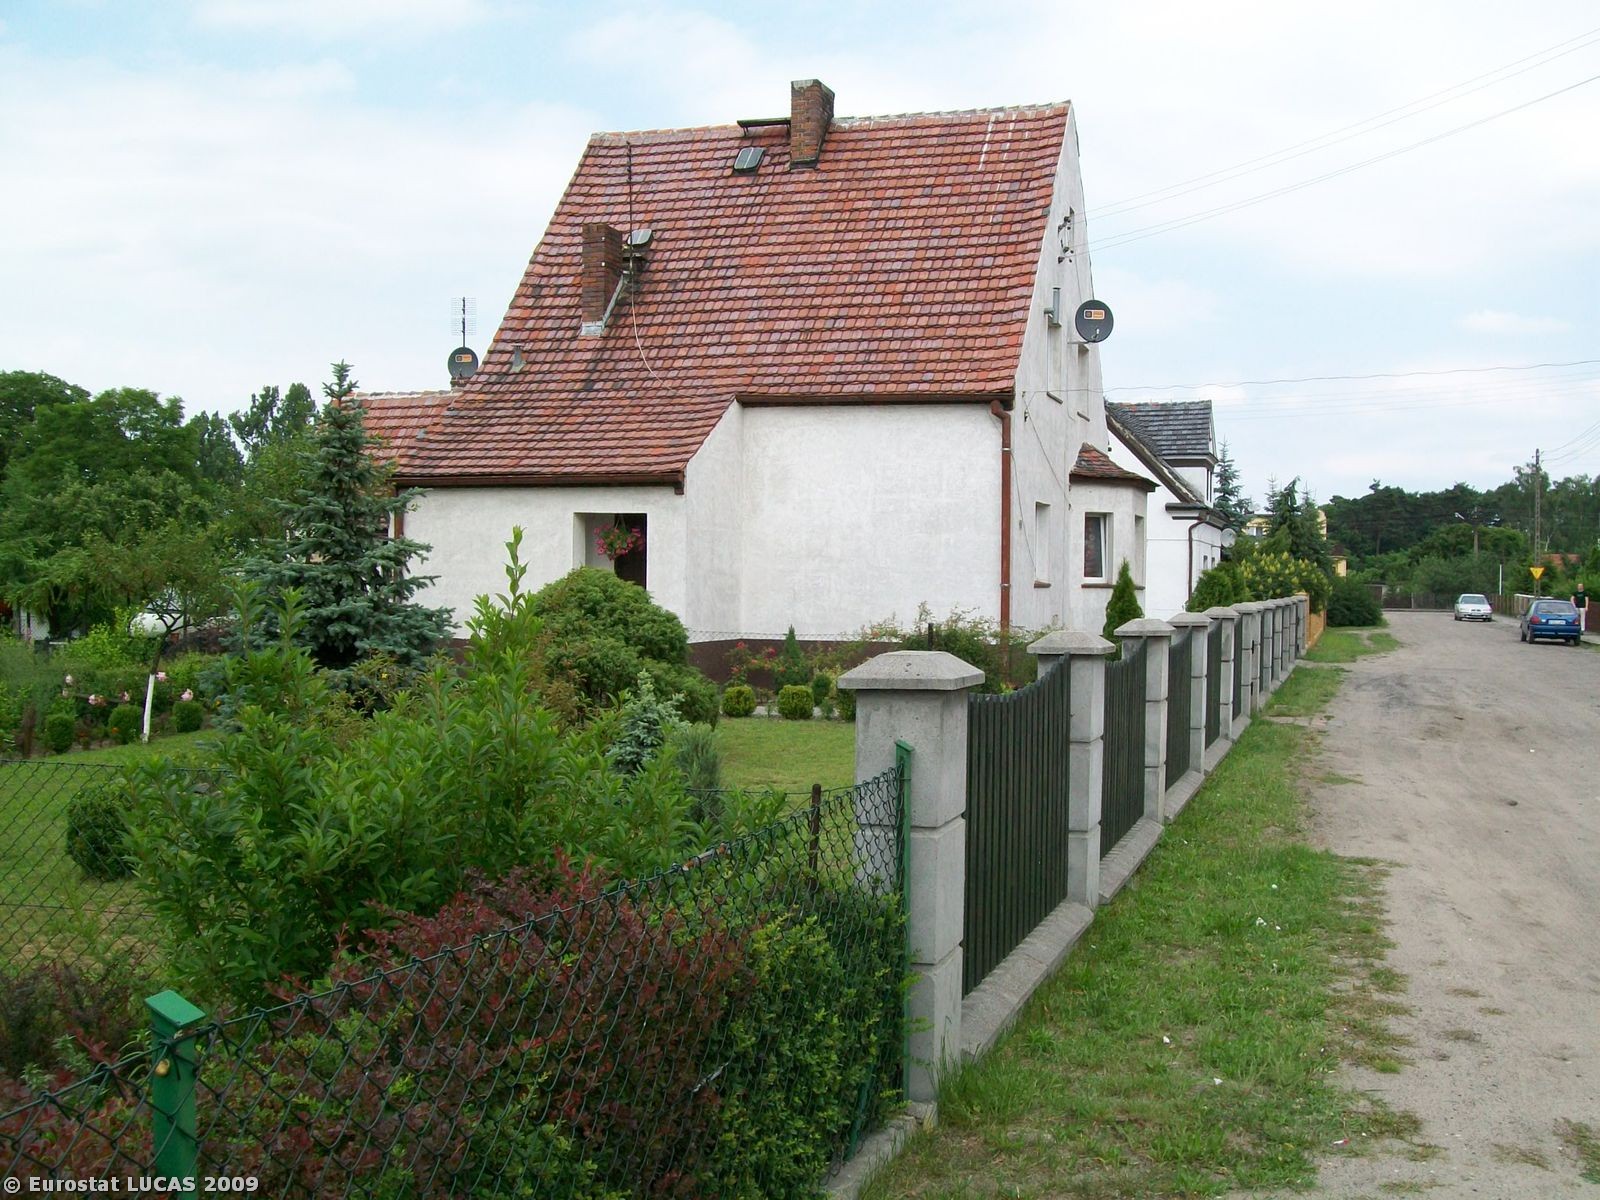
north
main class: Cropland
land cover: Floriculture and ornamental plants
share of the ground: > 75 %
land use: Kitchen garden
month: June
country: PL
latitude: 51.5068
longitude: 15.2046
